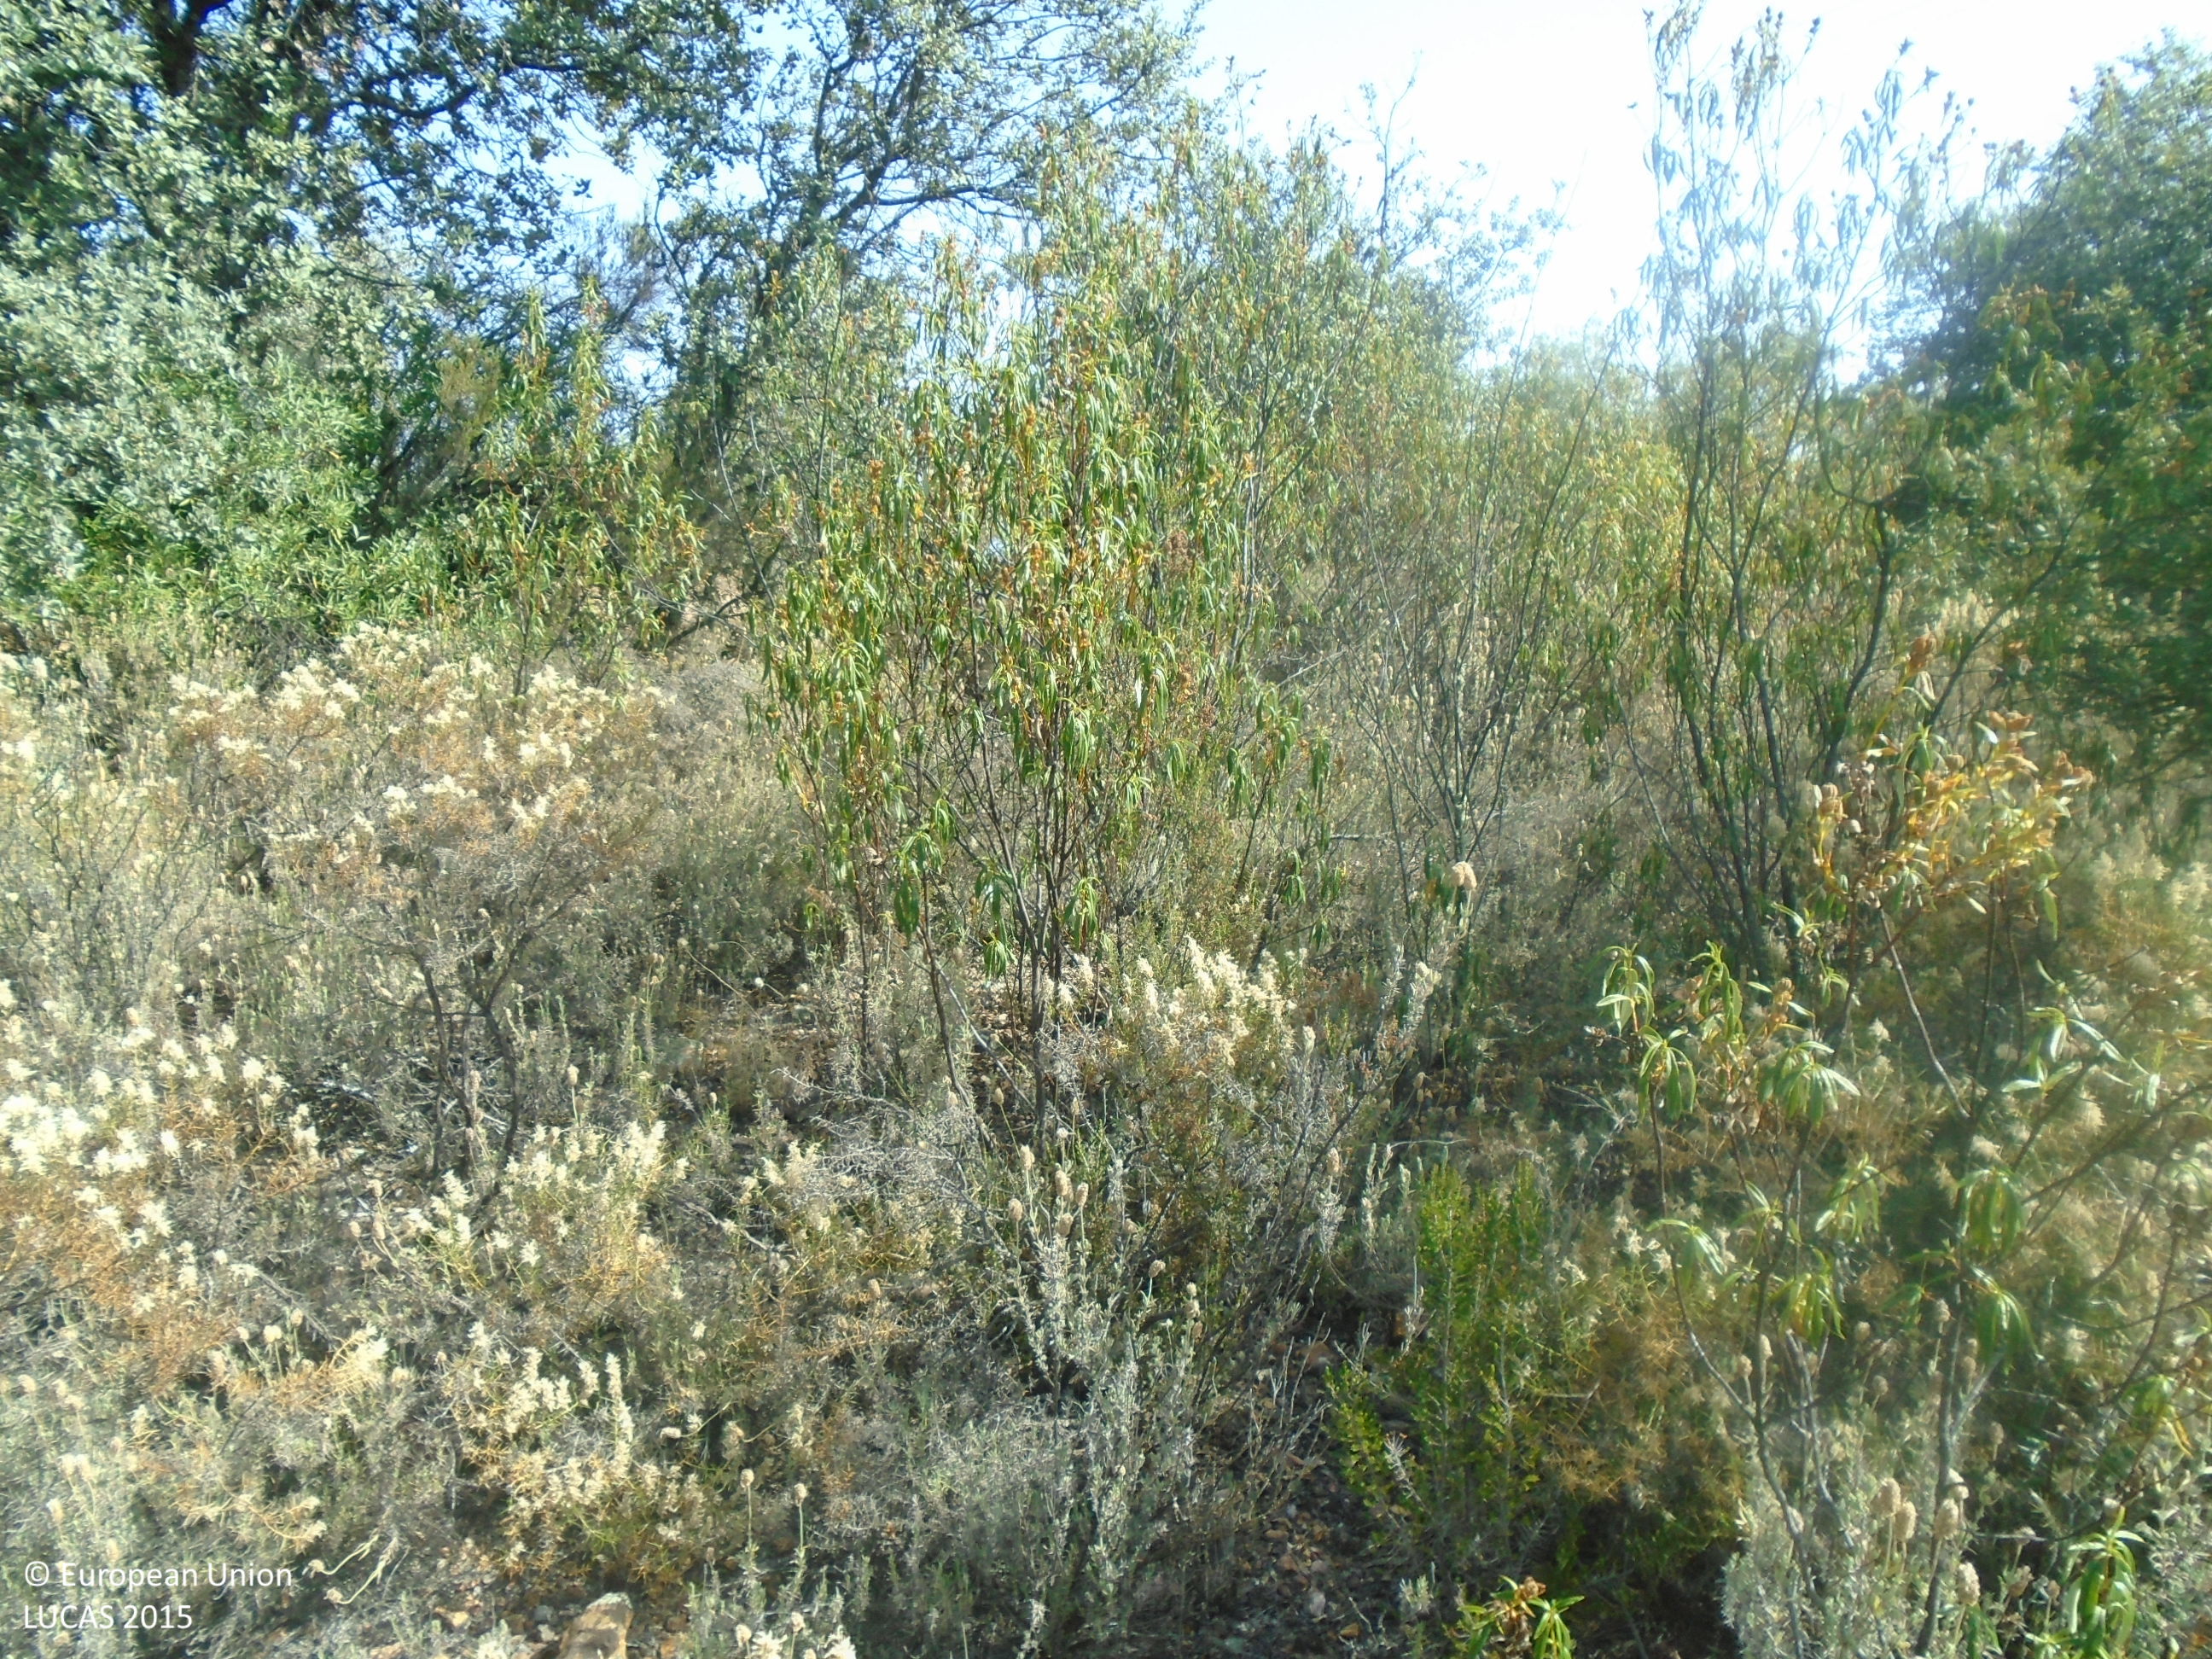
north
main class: Shrubland
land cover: Shrubland with sparse tree cover
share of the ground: > 75 %
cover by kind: shrubs 85 %, consolidated bare surface 10 %, broadleaved forest trees 5 %
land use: Semi-natural and natural areas not in use
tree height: < 5 m
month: July
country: ES
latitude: 39.3632
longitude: -4.6482
